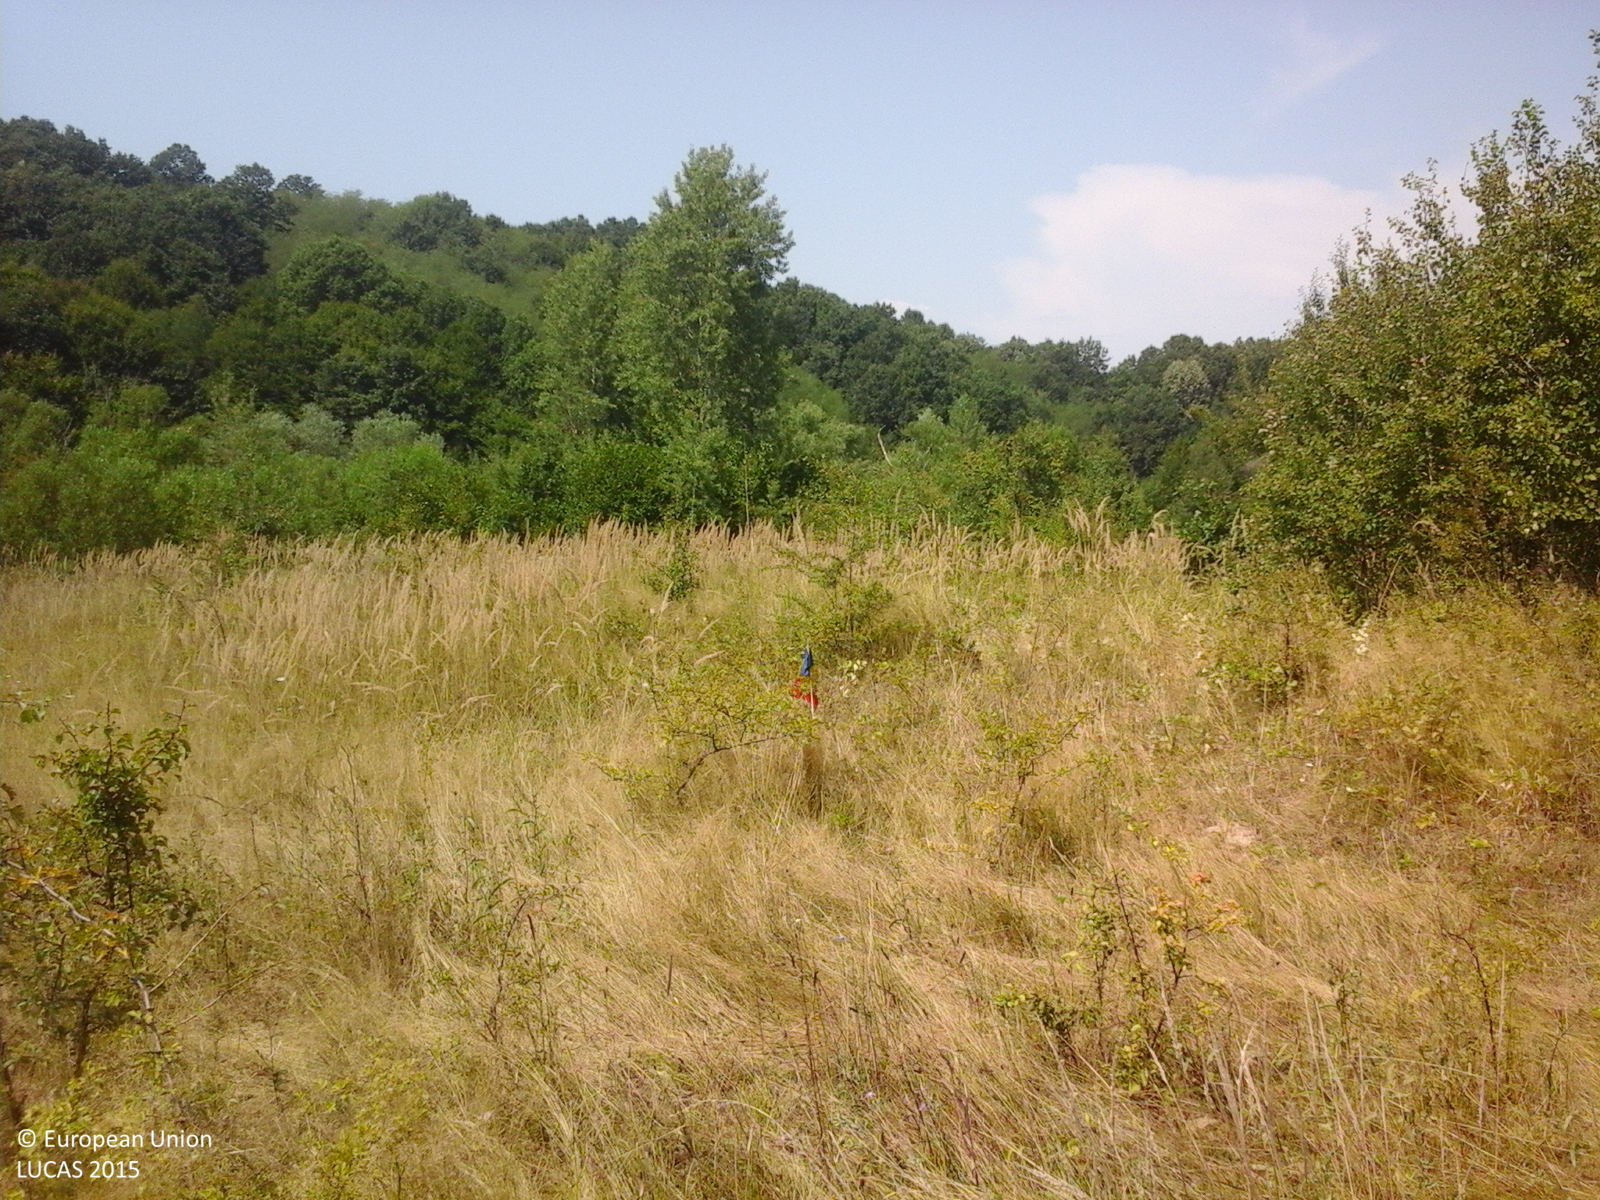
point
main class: Grassland
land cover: Grassland with sparse tree/shrub cover
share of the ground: > 75 %
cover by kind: herbaceous plants 85 %, shrubs 10 %, broadleaved forest trees 5 %
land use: Fallow land
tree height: < 5 m
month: August
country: RO
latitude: 44.7330
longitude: 23.7089
